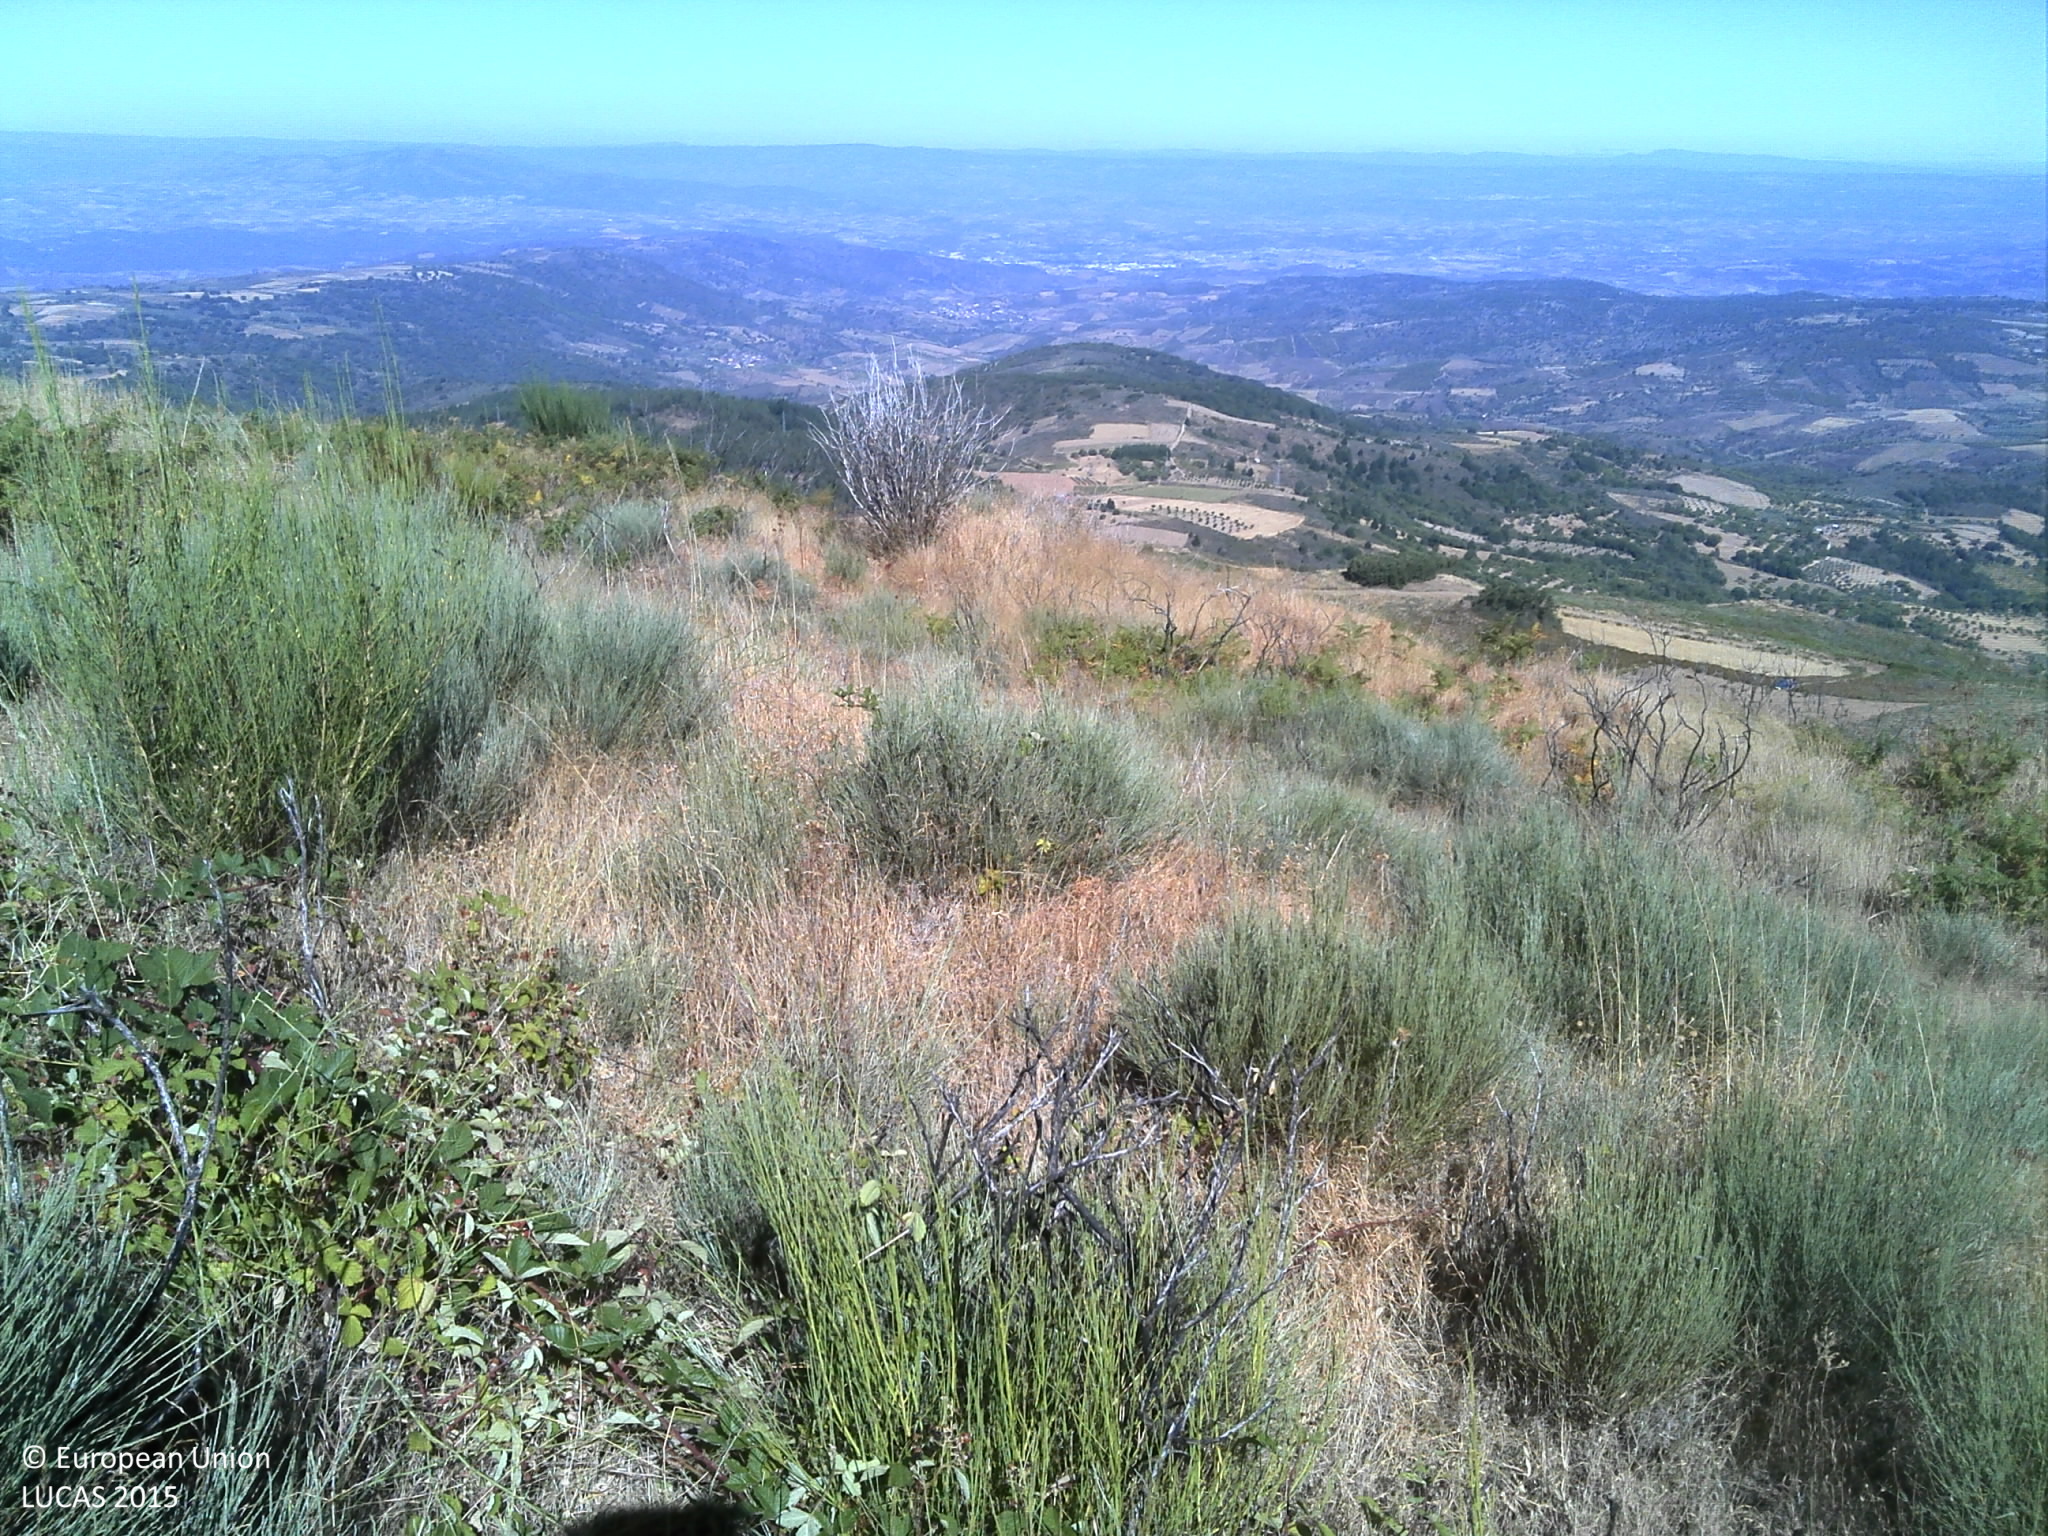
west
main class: Shrubland
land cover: Shrubland without tree cover
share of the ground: > 75 %
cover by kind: shrubs 95 %, herbaceous plants 5 %
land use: Abandoned areas
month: July
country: PT
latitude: 41.4436
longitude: -7.0021
